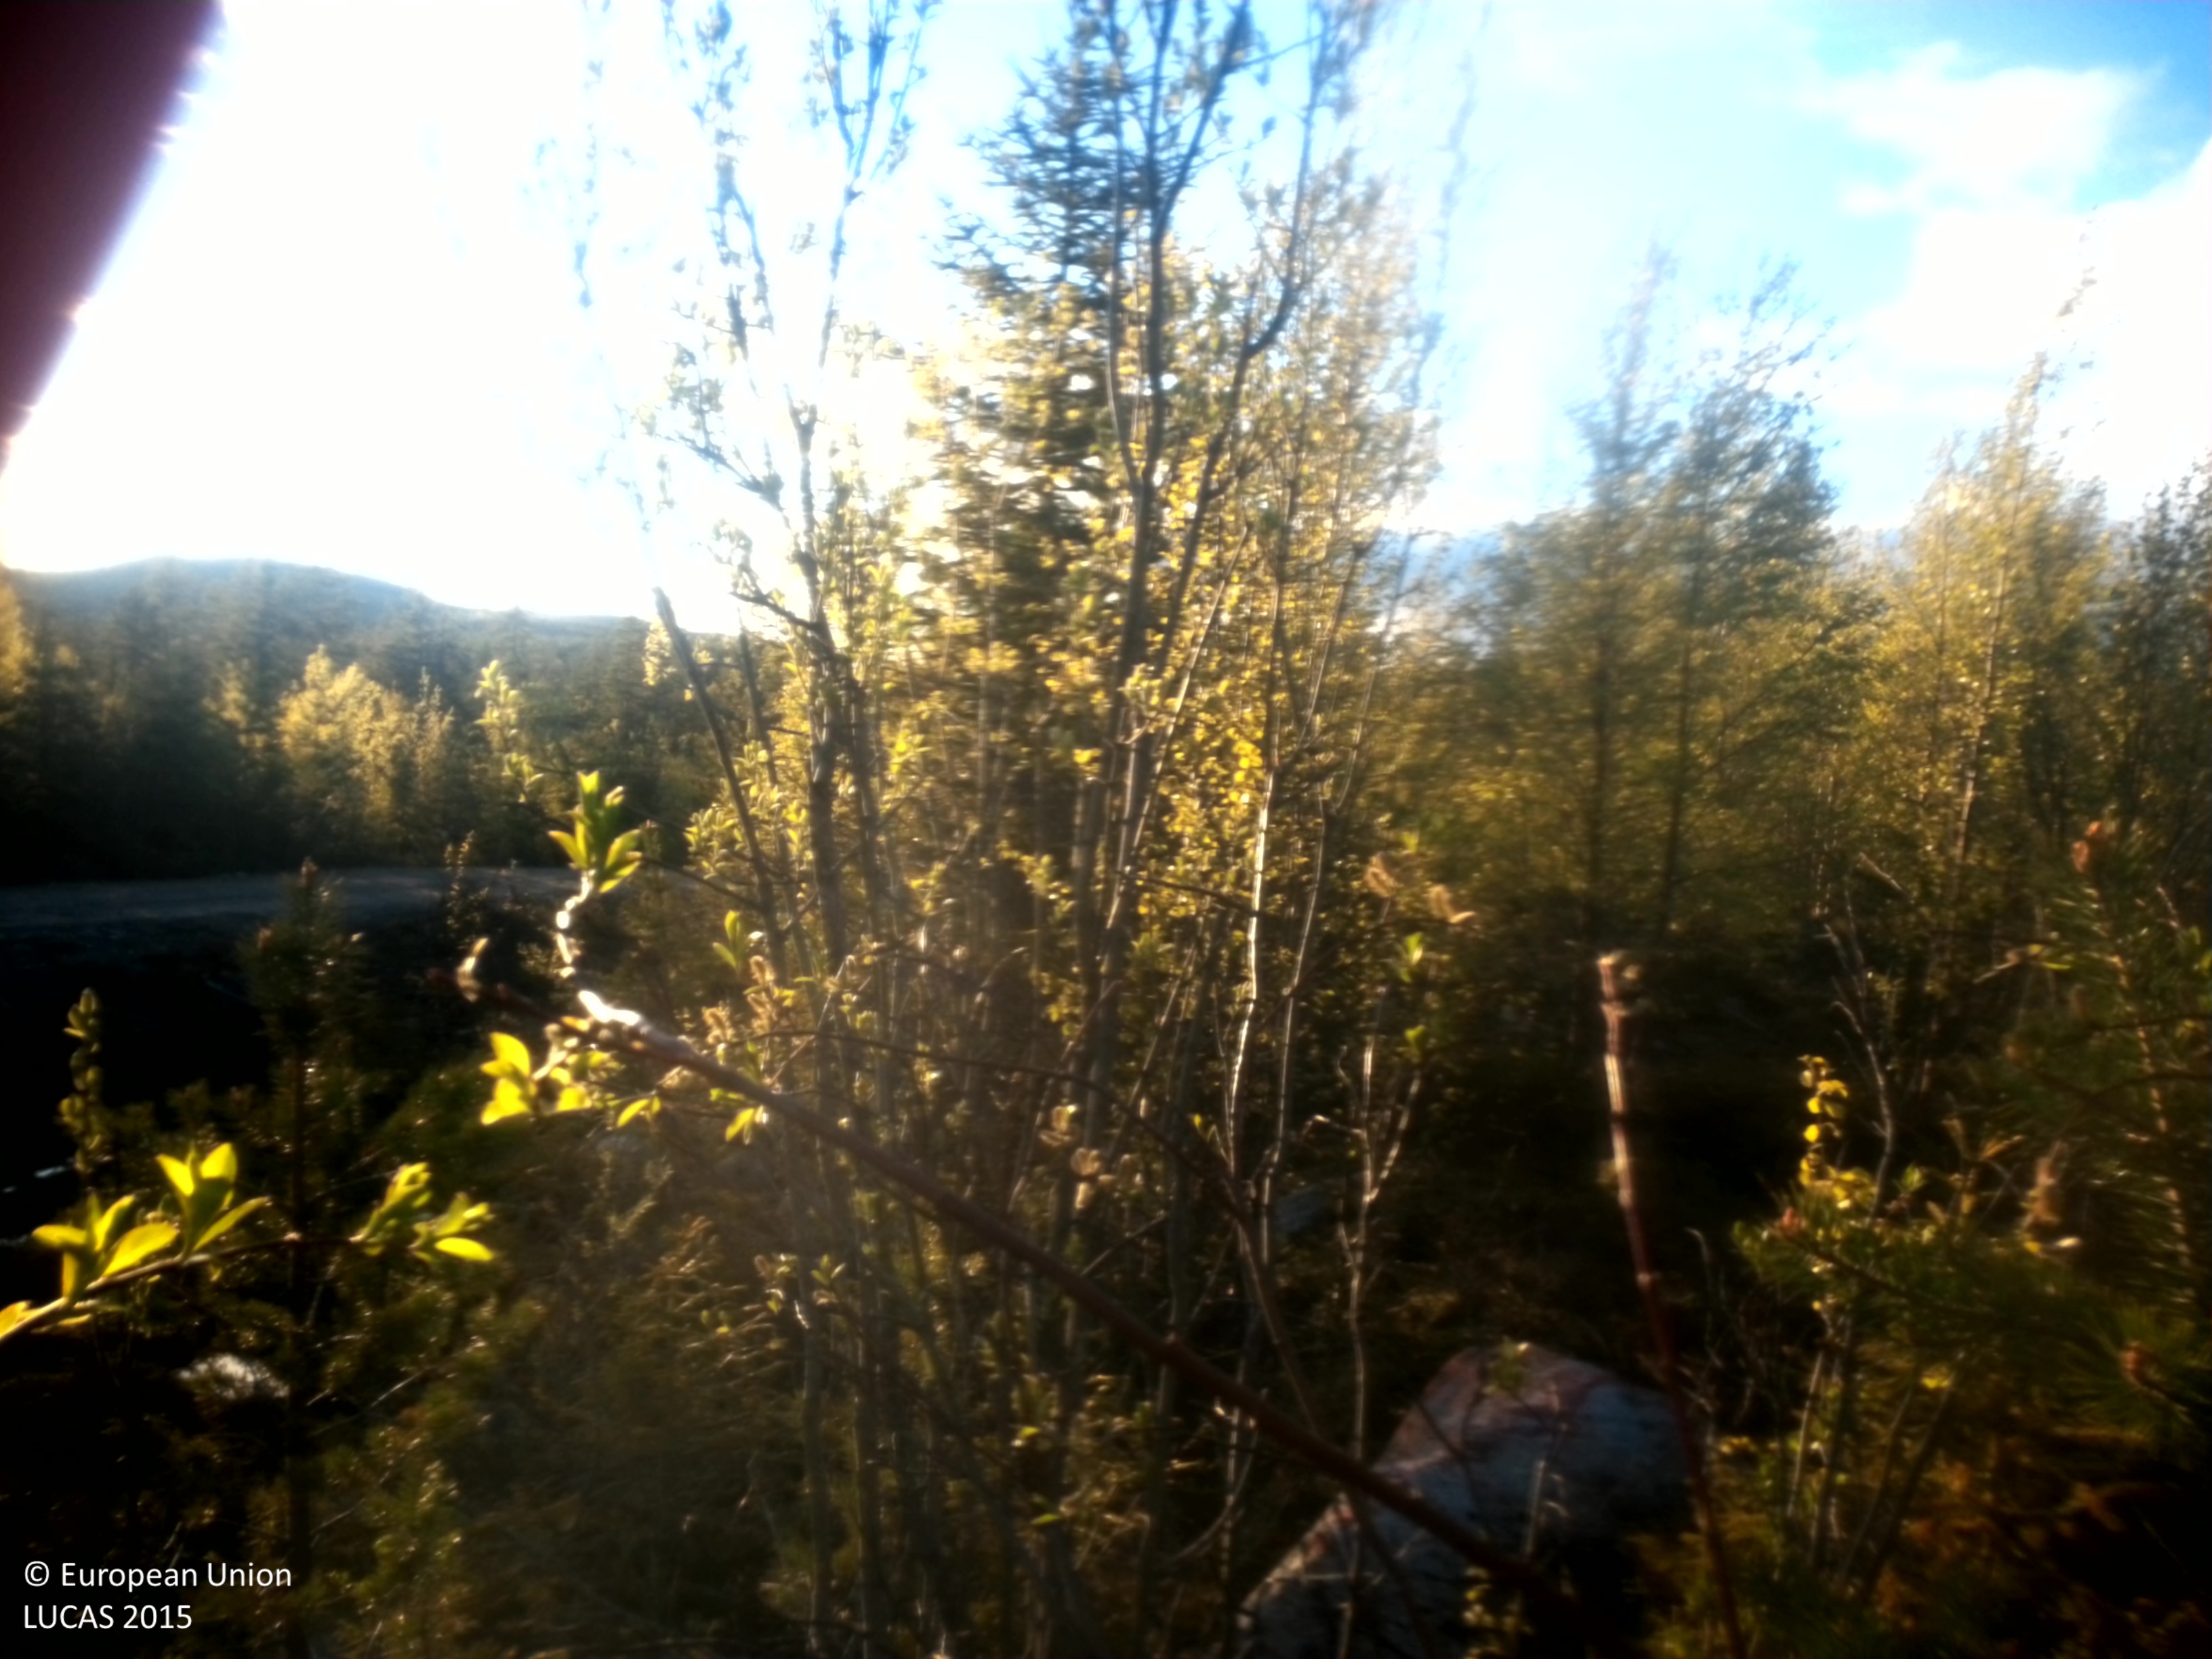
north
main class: Woodland
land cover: Broadleaved woodland
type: boreal forest
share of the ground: 25 - 50 %
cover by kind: broadleaved forest trees 35 %, herbaceous plants 20 %, lichens and mosses 20 %, shrubs 10 %, coniferous forest trees 5 %, unconsolidated bare surface 5 %
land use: Forestry
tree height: < 5 m
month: June
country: SE
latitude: 64.4144
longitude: 17.6259
